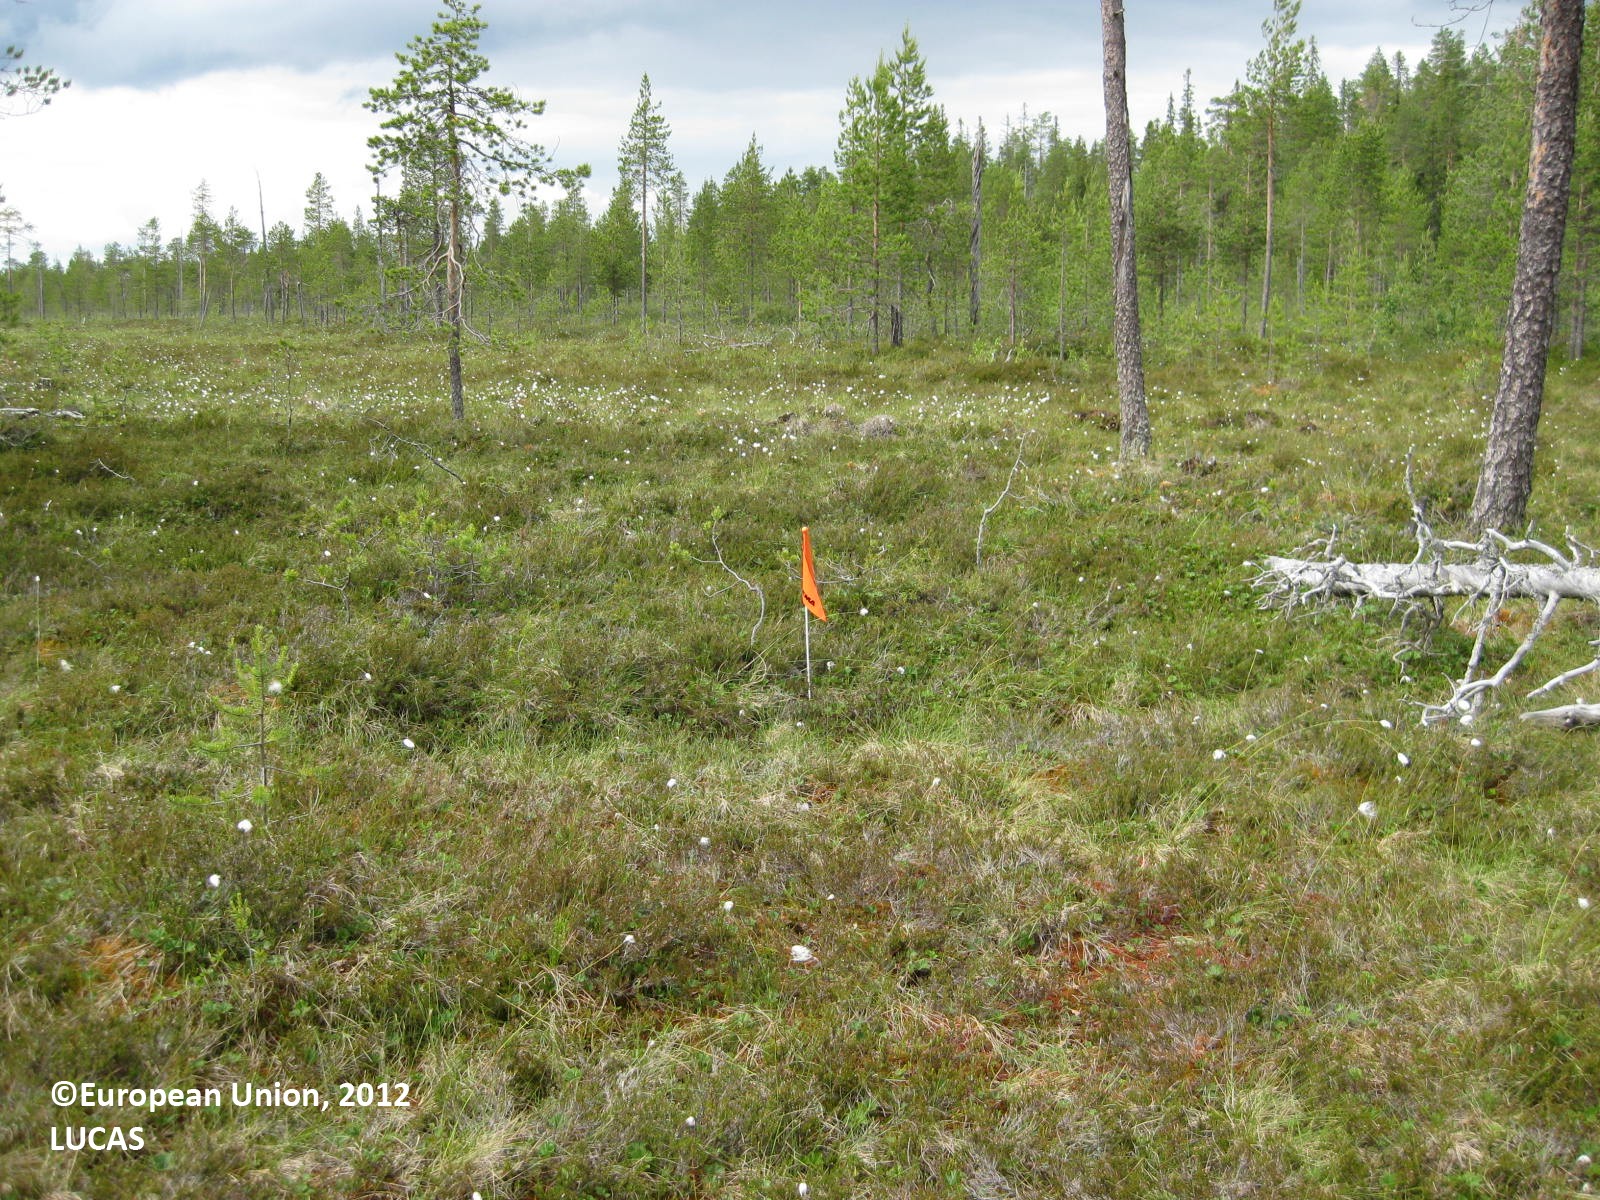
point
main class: Wetlands
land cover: Peatbogs
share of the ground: < 10 %
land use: Semi-natural and natural areas not in use
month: July
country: FI
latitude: 65.4436
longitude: 28.3359
